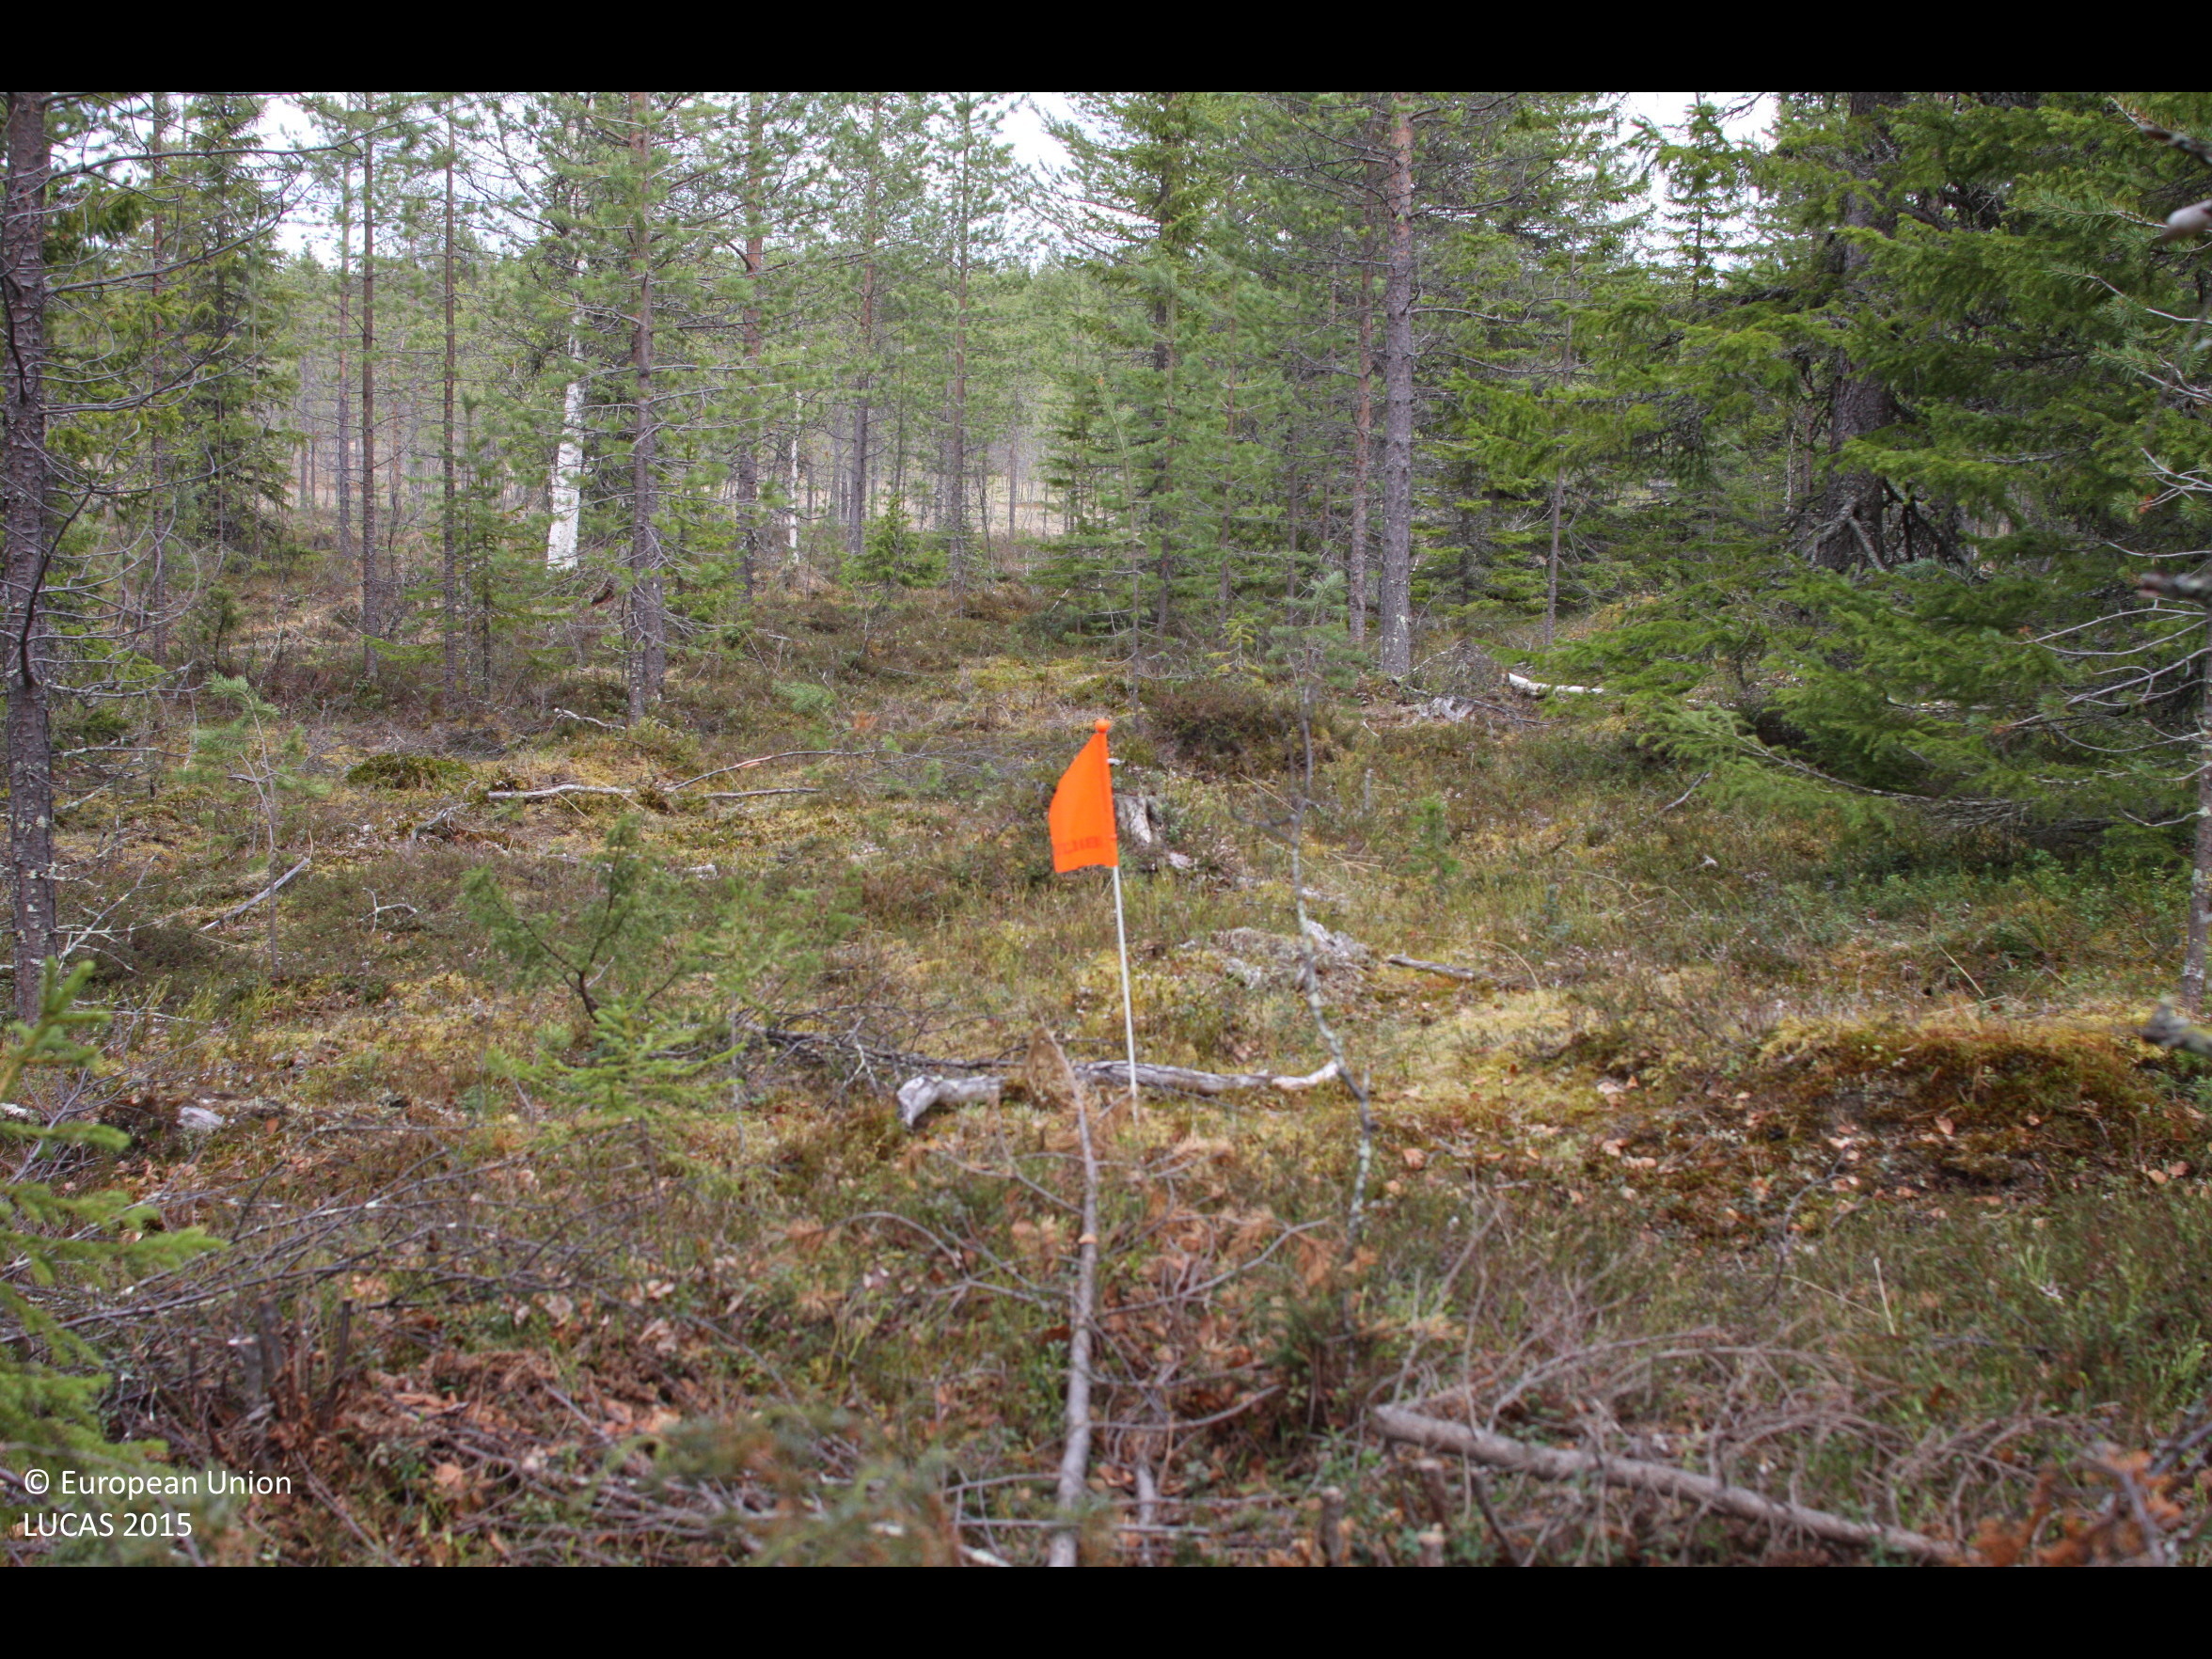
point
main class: Woodland
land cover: Pine dominated coniferous woodland
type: boreal forest
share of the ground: > 75 %
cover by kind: coniferous forest trees 70 %, shrubs 20 %, broadleaved forest trees 5 %, lichens and mosses 5 %
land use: Forestry
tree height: > 5 m
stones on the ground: < 10 %
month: June
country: FI
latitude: 66.1751
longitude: 27.8104
